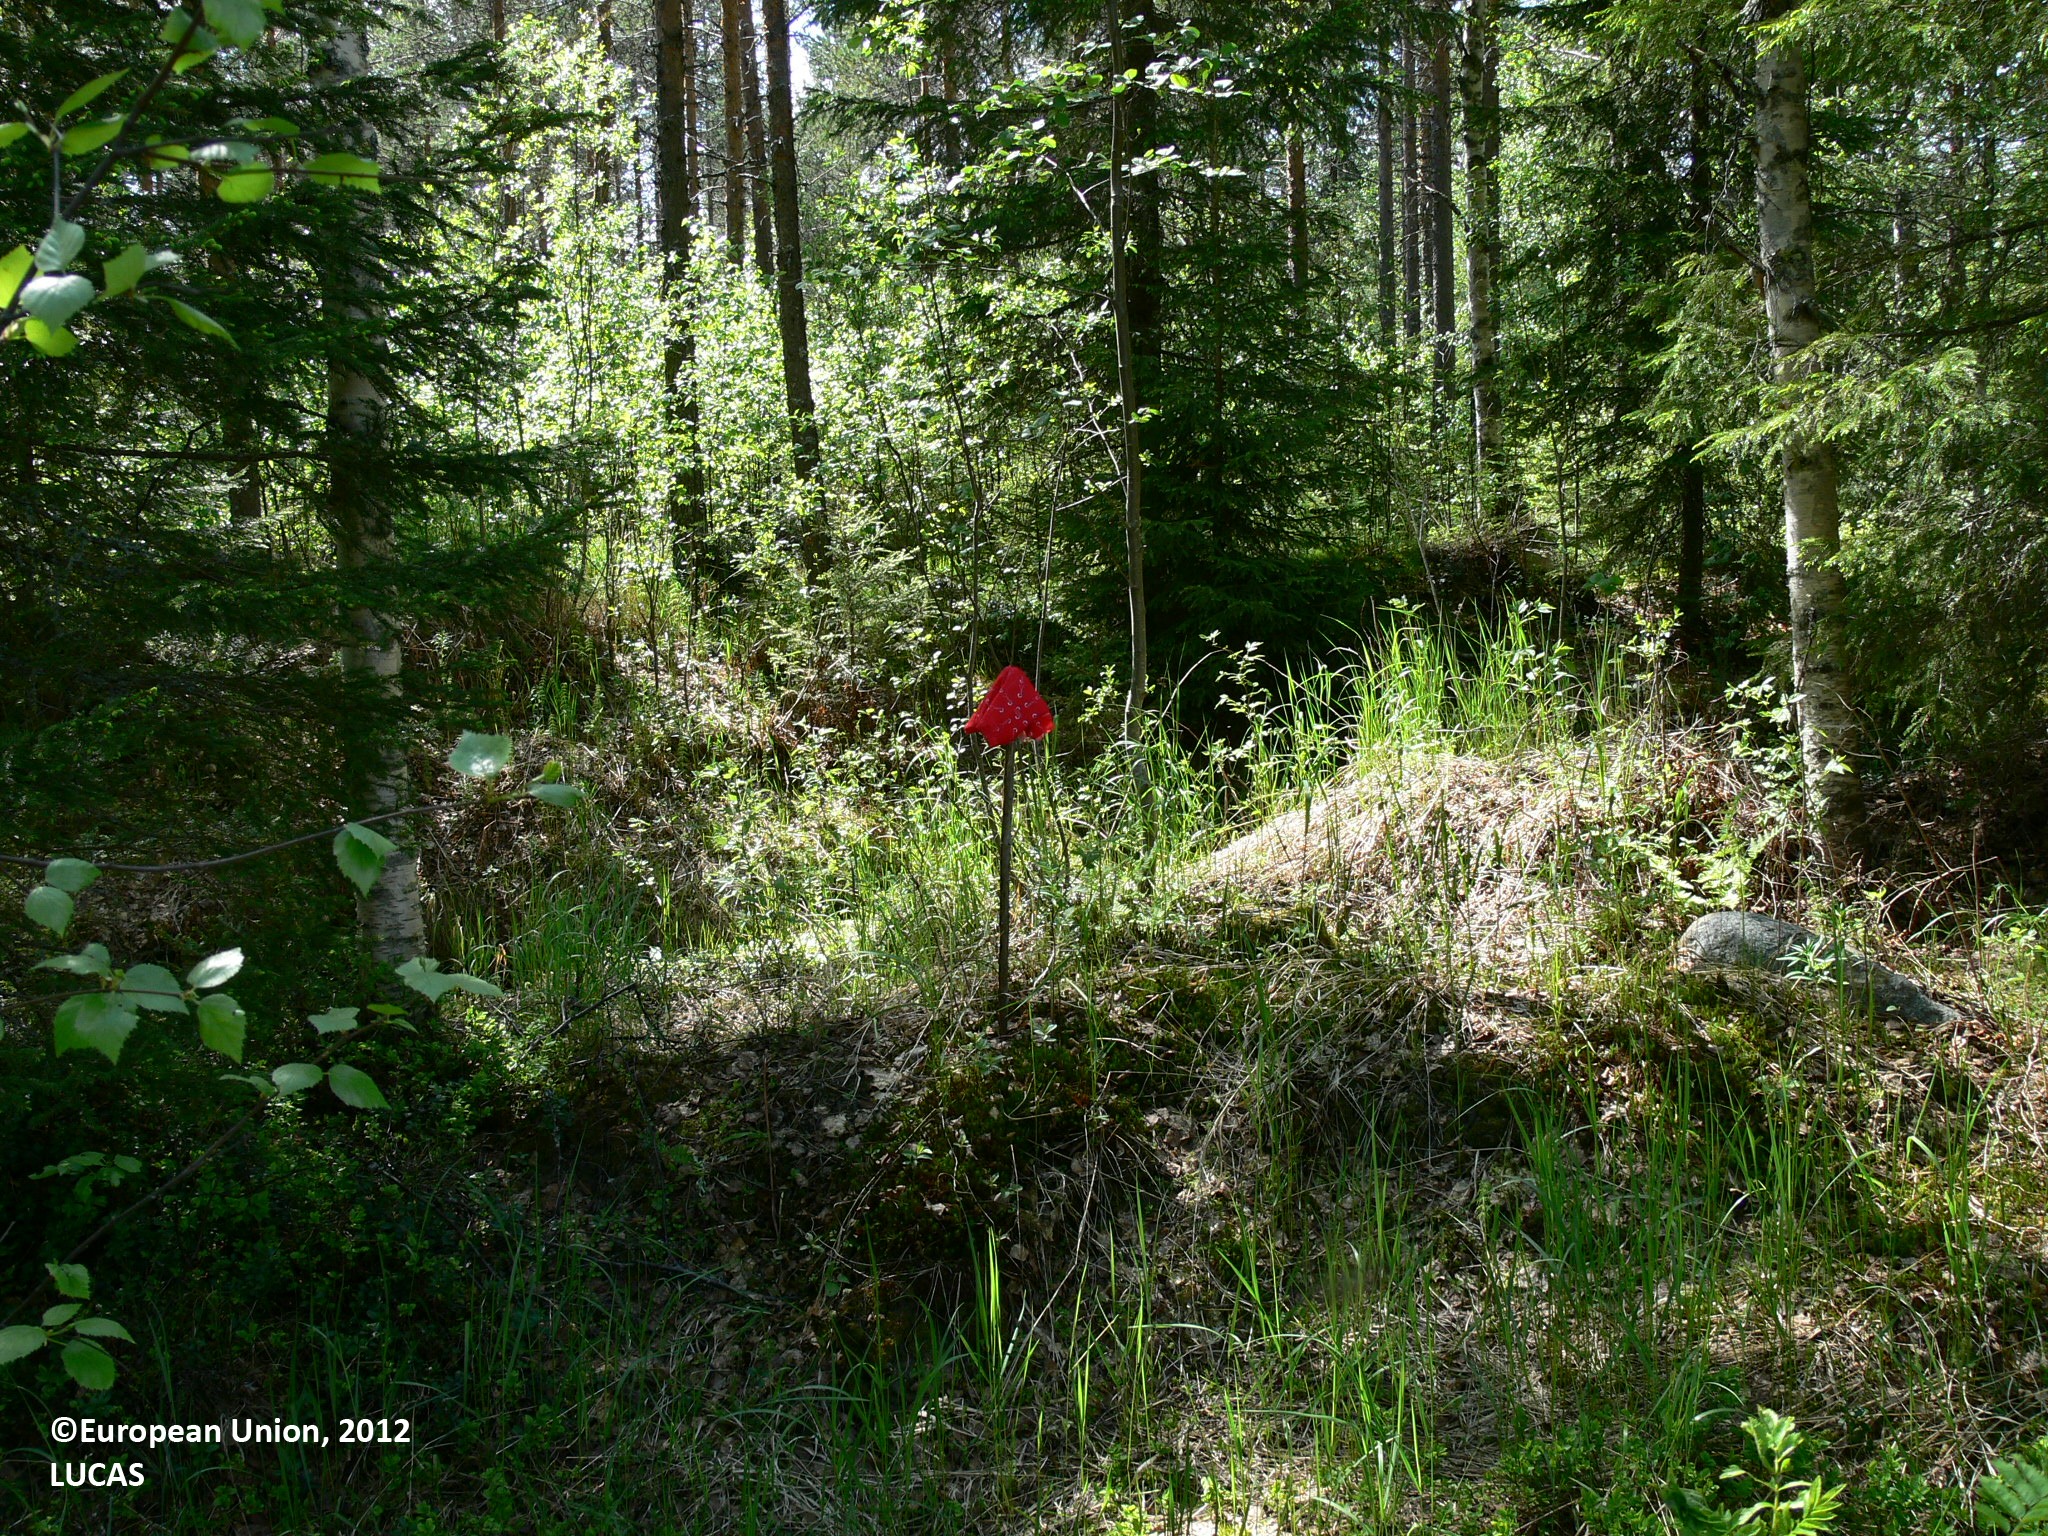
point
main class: Woodland
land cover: Other mixed woodland
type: boreal forest
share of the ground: > 75 %
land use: Forestry
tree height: > 5 m
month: June
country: FI
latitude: 62.5961
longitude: 30.8027
